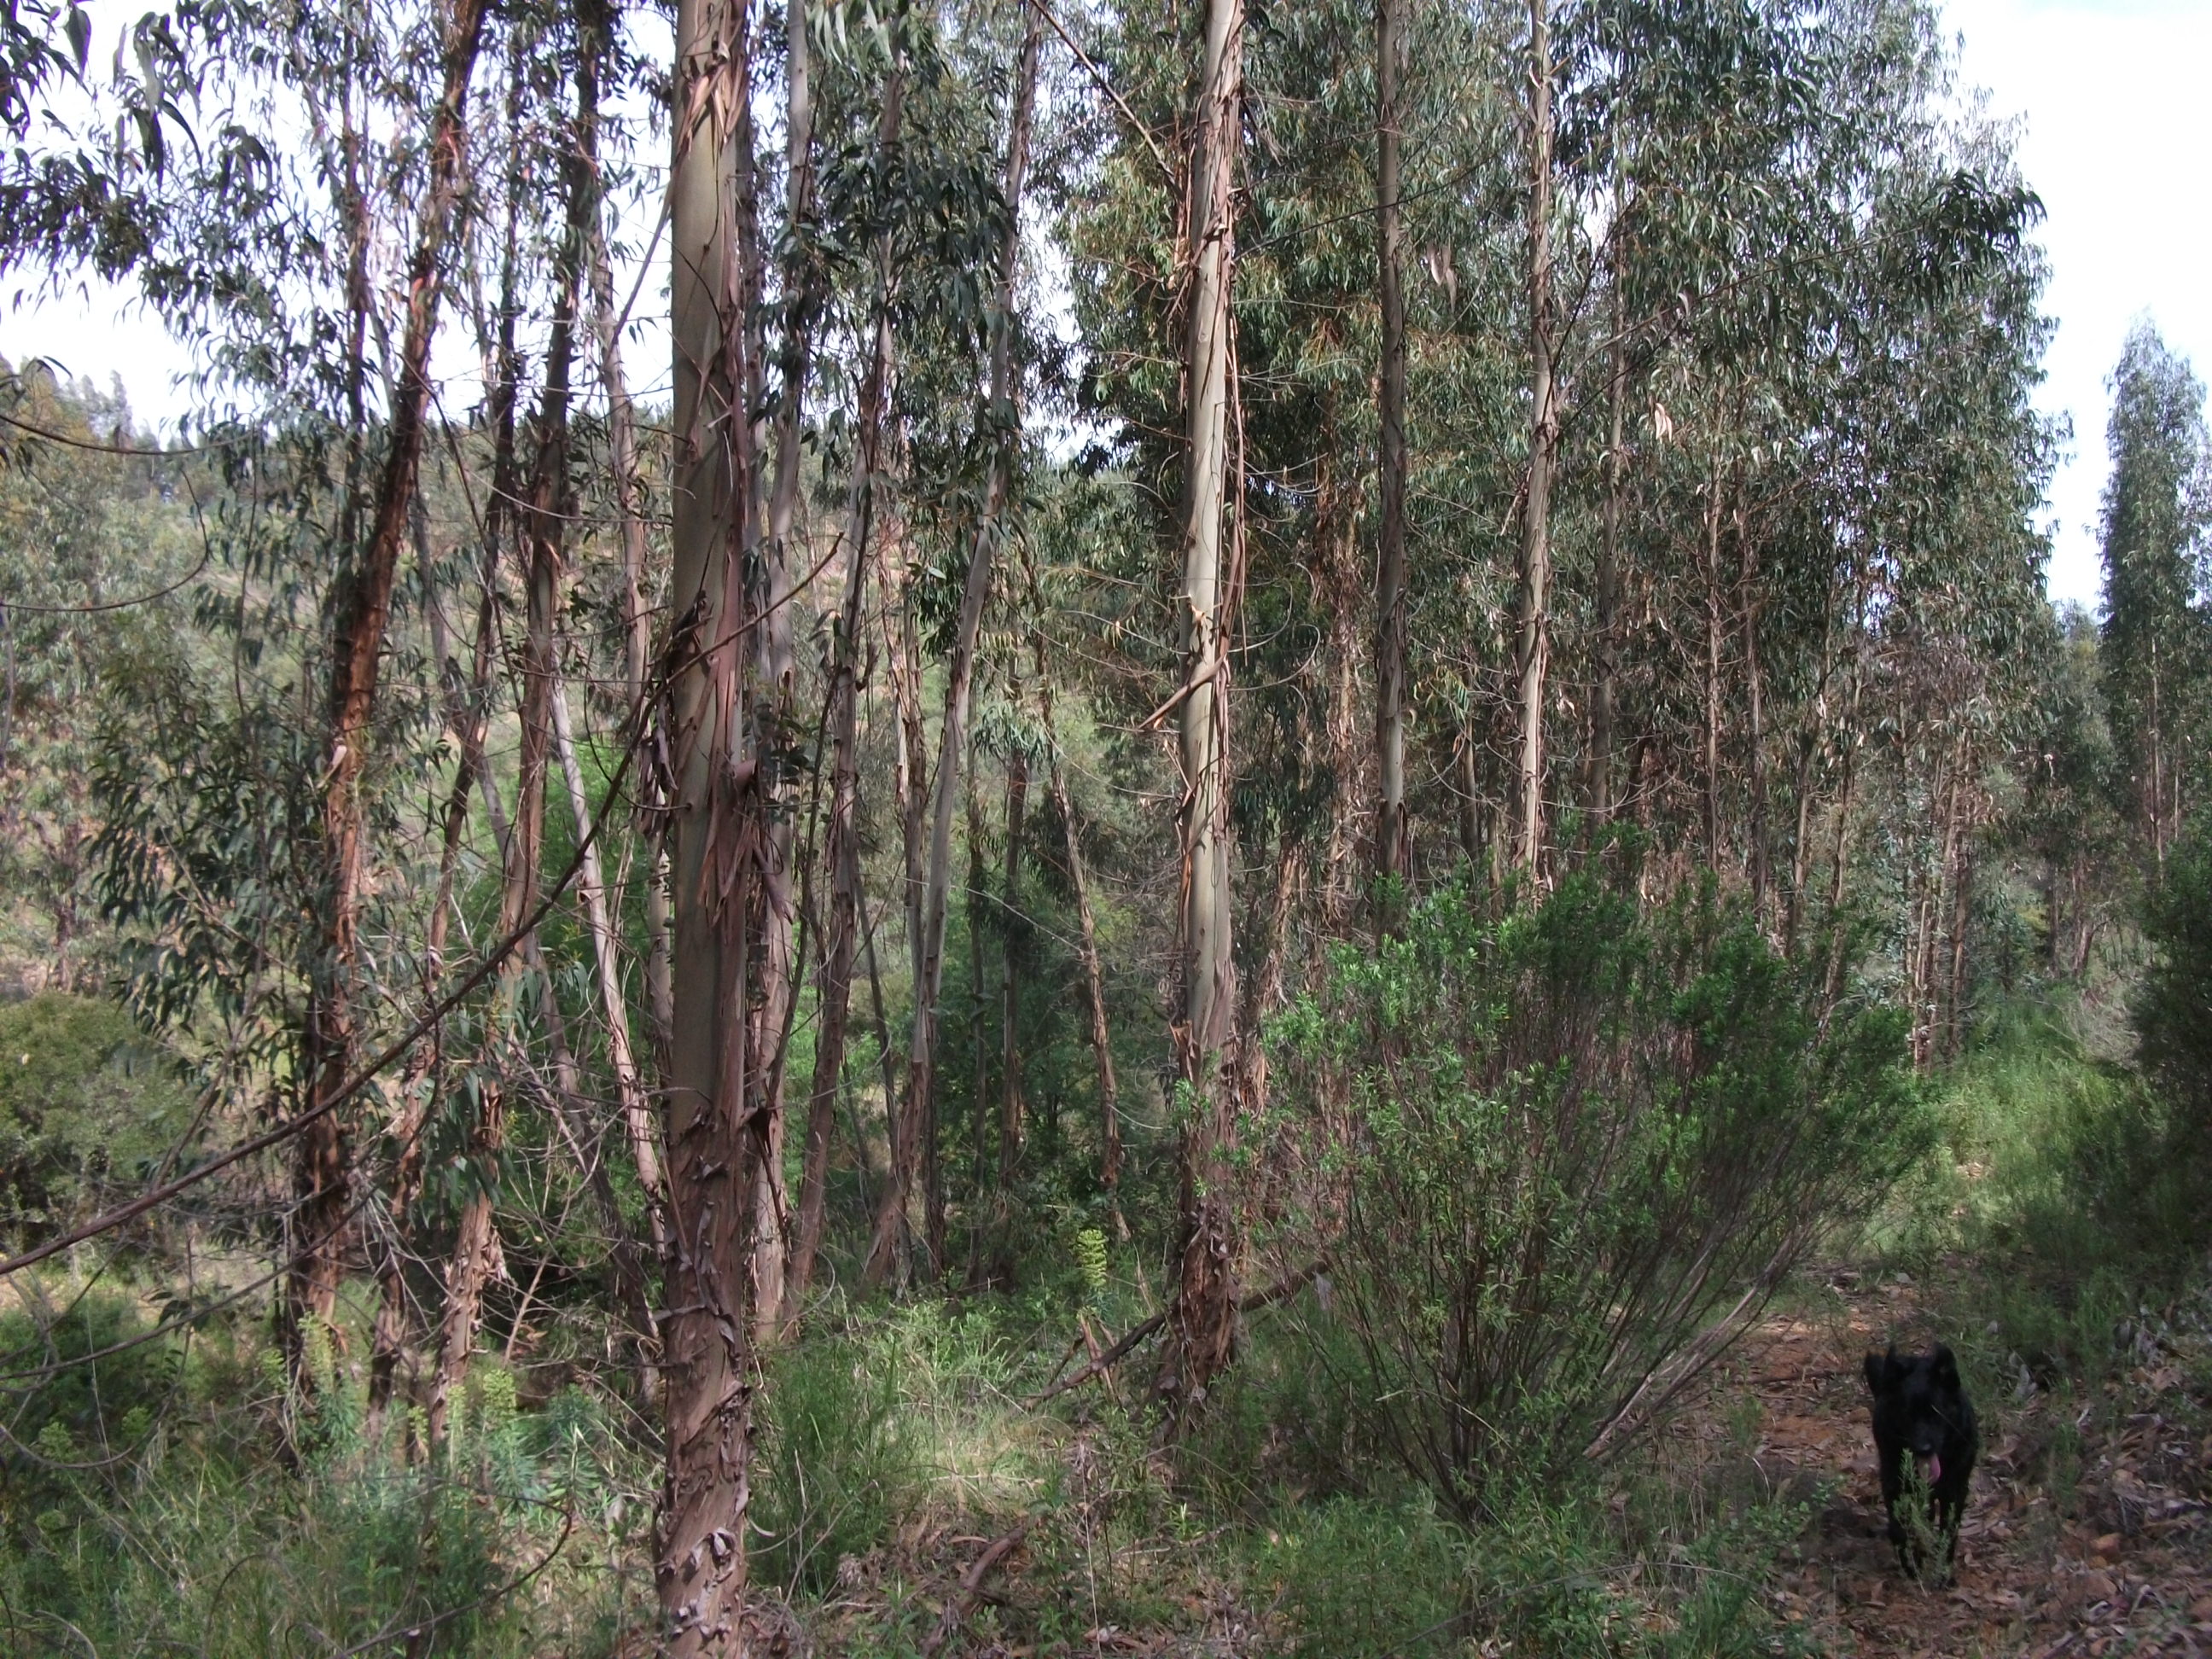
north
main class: Woodland
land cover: Broadleaved woodland
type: broadleaved evergreen forest
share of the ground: 25 - 50 %
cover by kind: shrubs 50 %, broadleaved forest trees 40 %
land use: Forestry
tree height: > 5 m
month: April
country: ES
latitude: 37.8304
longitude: -6.4812
